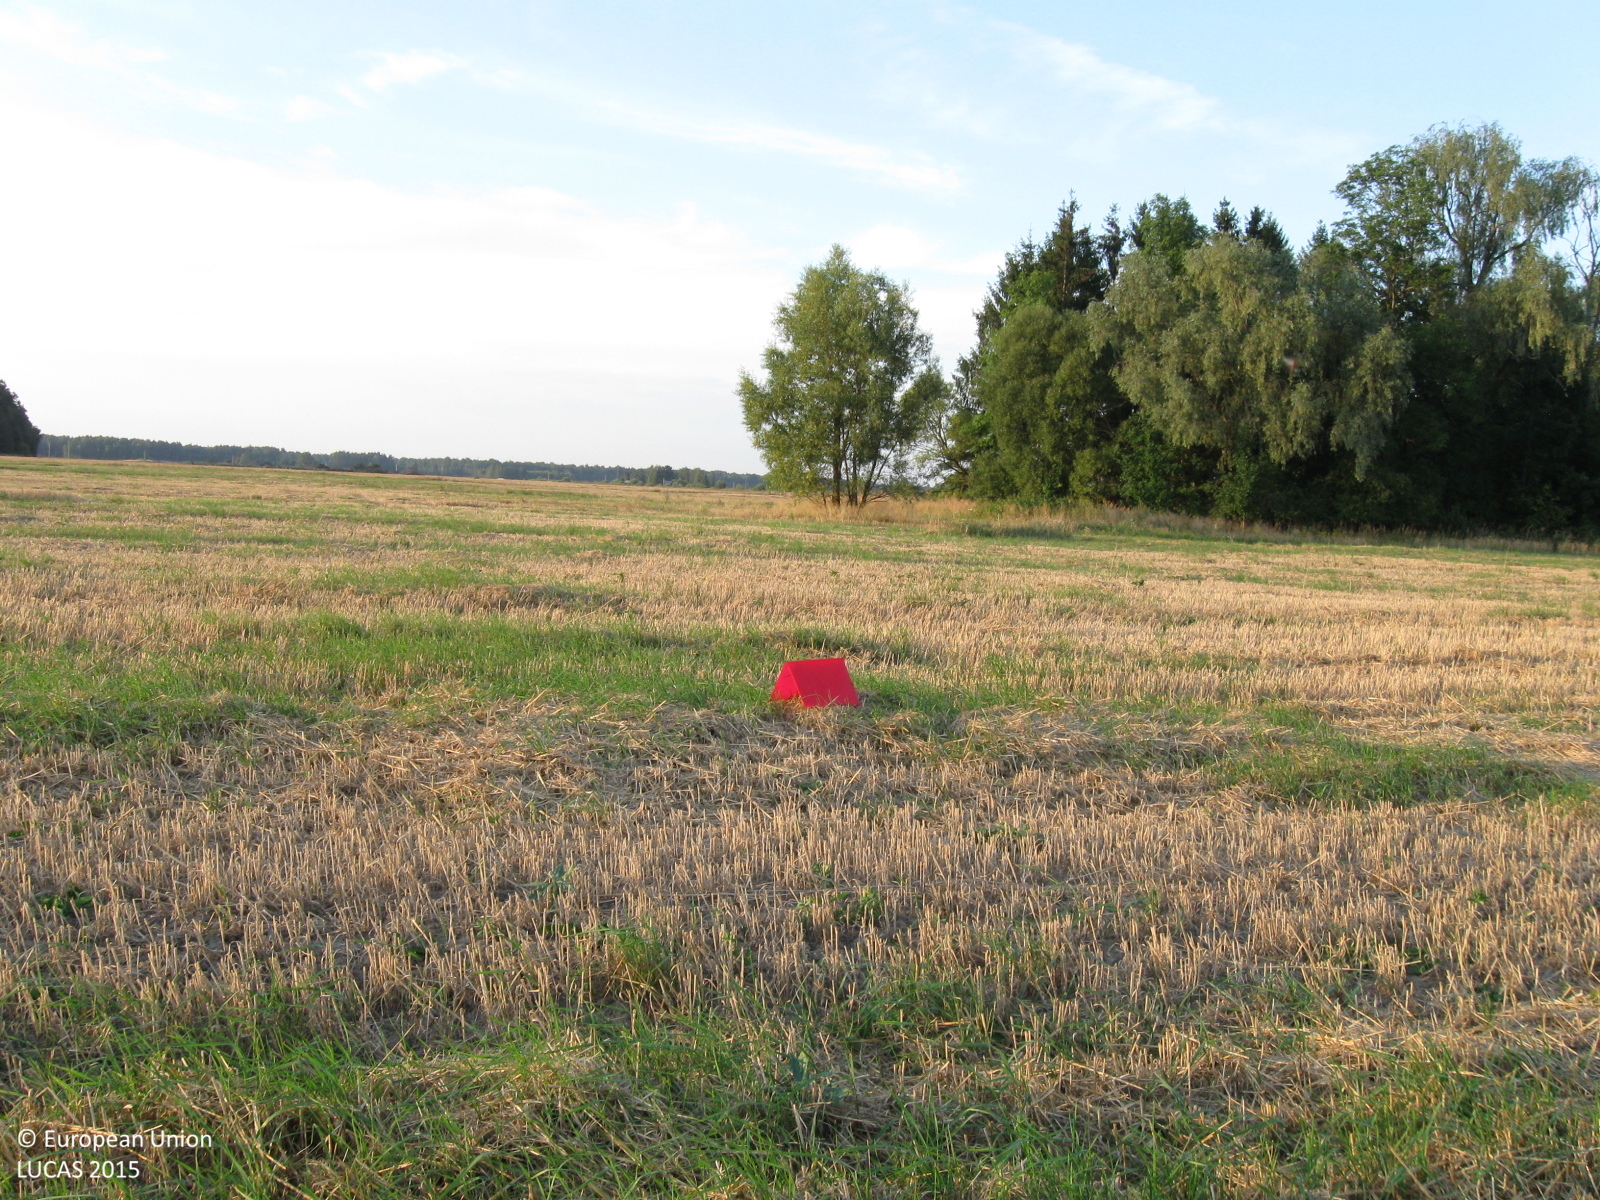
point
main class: Cropland
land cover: Common wheat
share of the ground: > 75 %
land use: Agriculture (excluding fallow land and kitchen gardens)
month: August
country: LT
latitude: 55.2876
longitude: 22.8054
